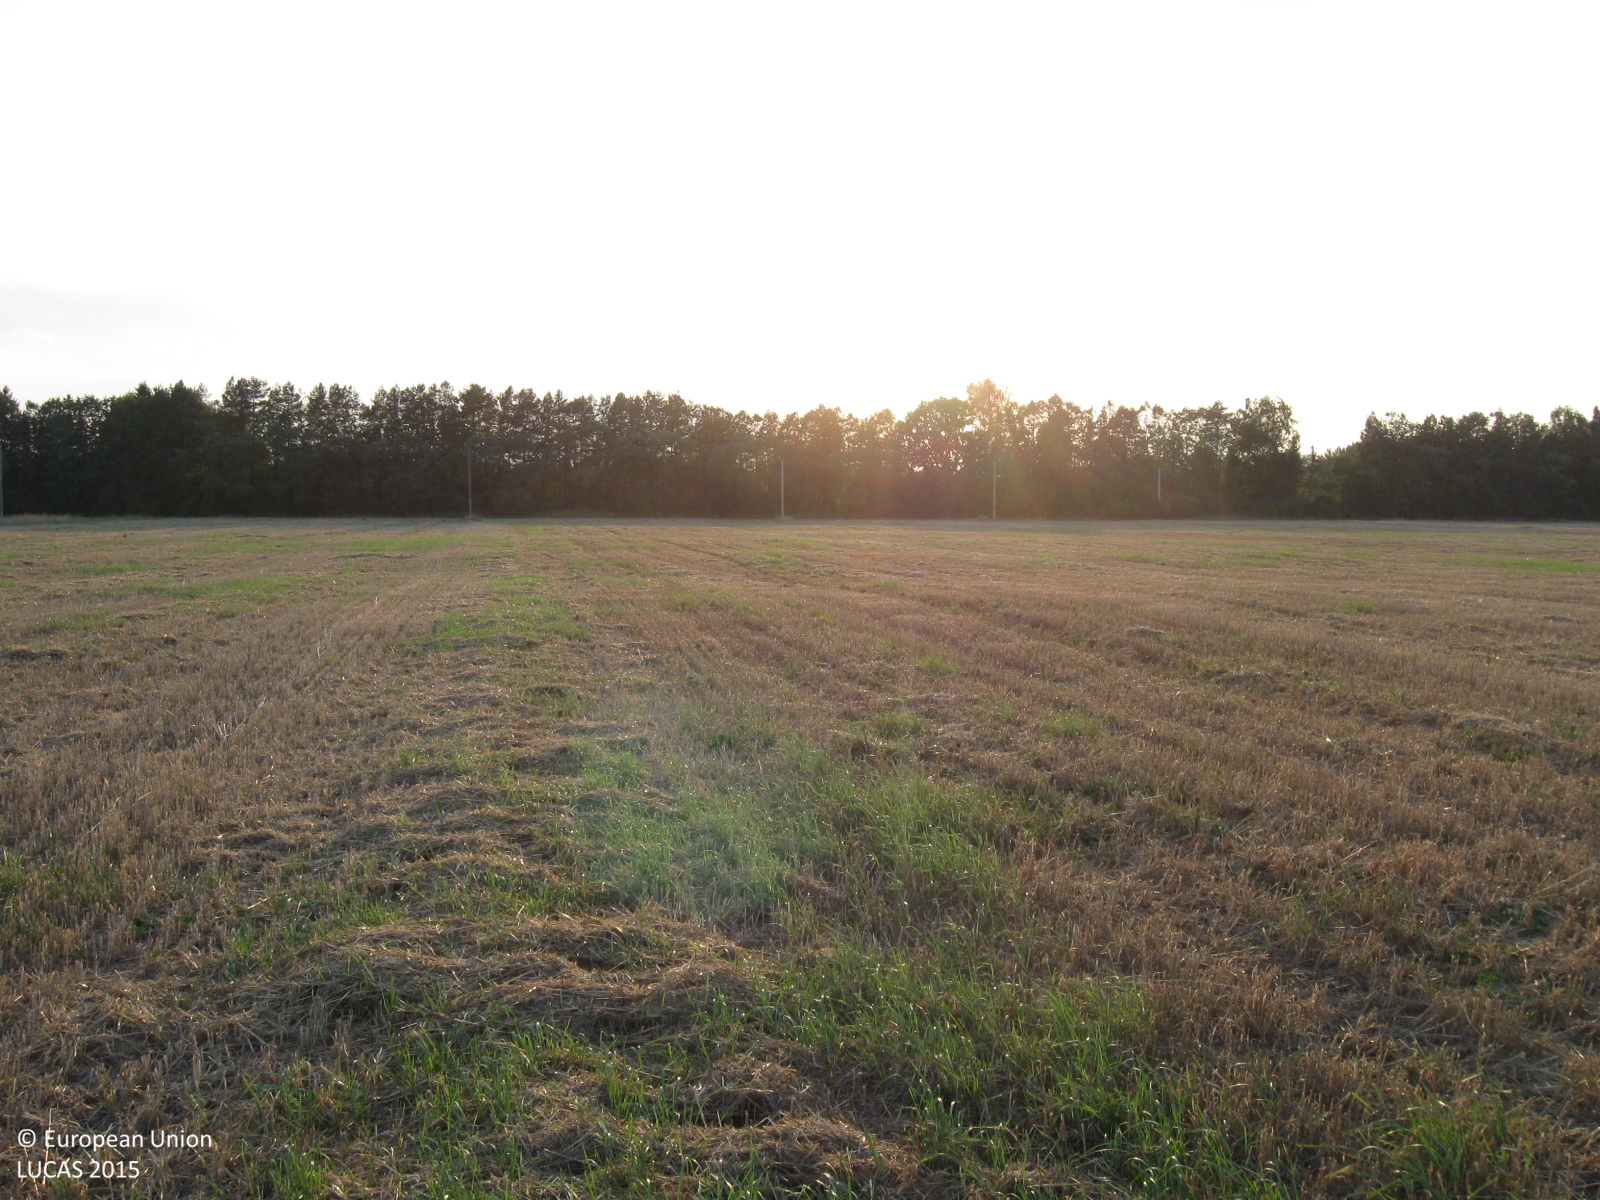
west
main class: Cropland
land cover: Common wheat
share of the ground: > 75 %
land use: Agriculture (excluding fallow land and kitchen gardens)
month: August
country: LT
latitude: 55.2876
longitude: 22.8054
